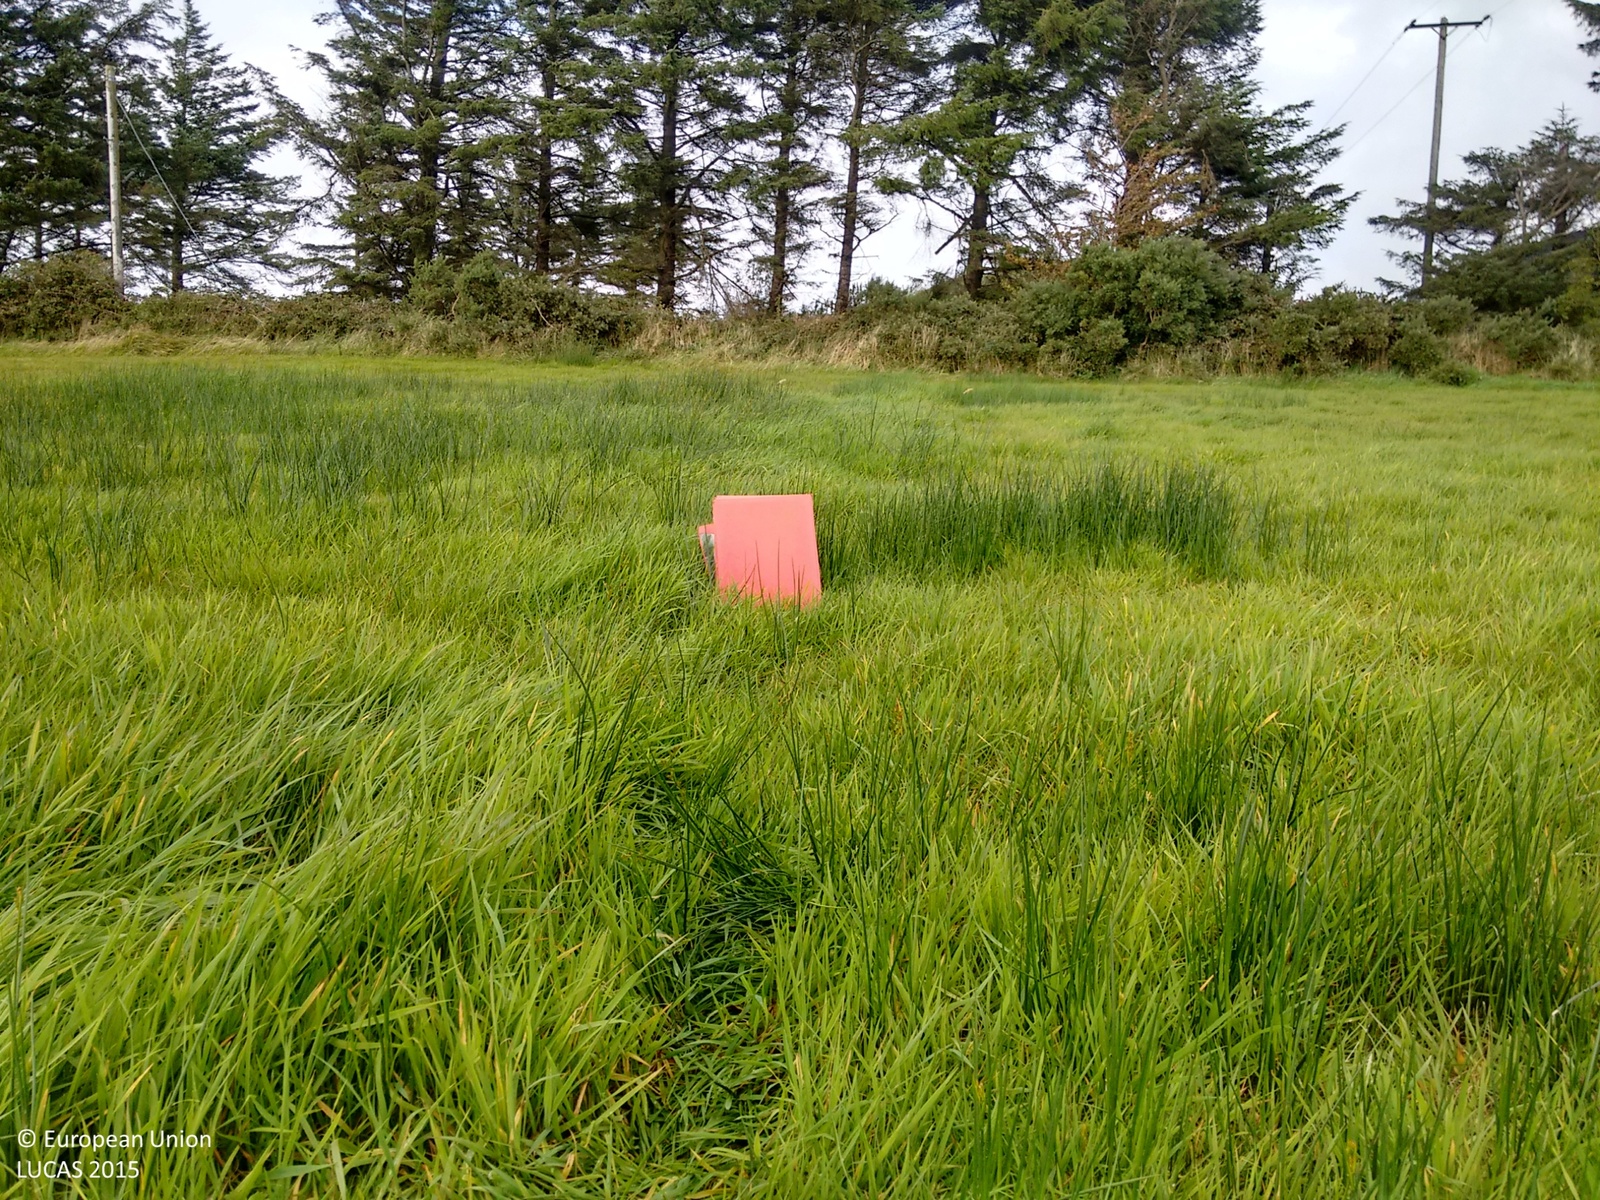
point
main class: Grassland
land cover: Grassland without tree/shrub cover
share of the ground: > 75 %
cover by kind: herbaceous plants 100 %
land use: Agriculture (excluding fallow land and kitchen gardens)
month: September
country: IE
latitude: 52.5280
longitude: -9.3140
